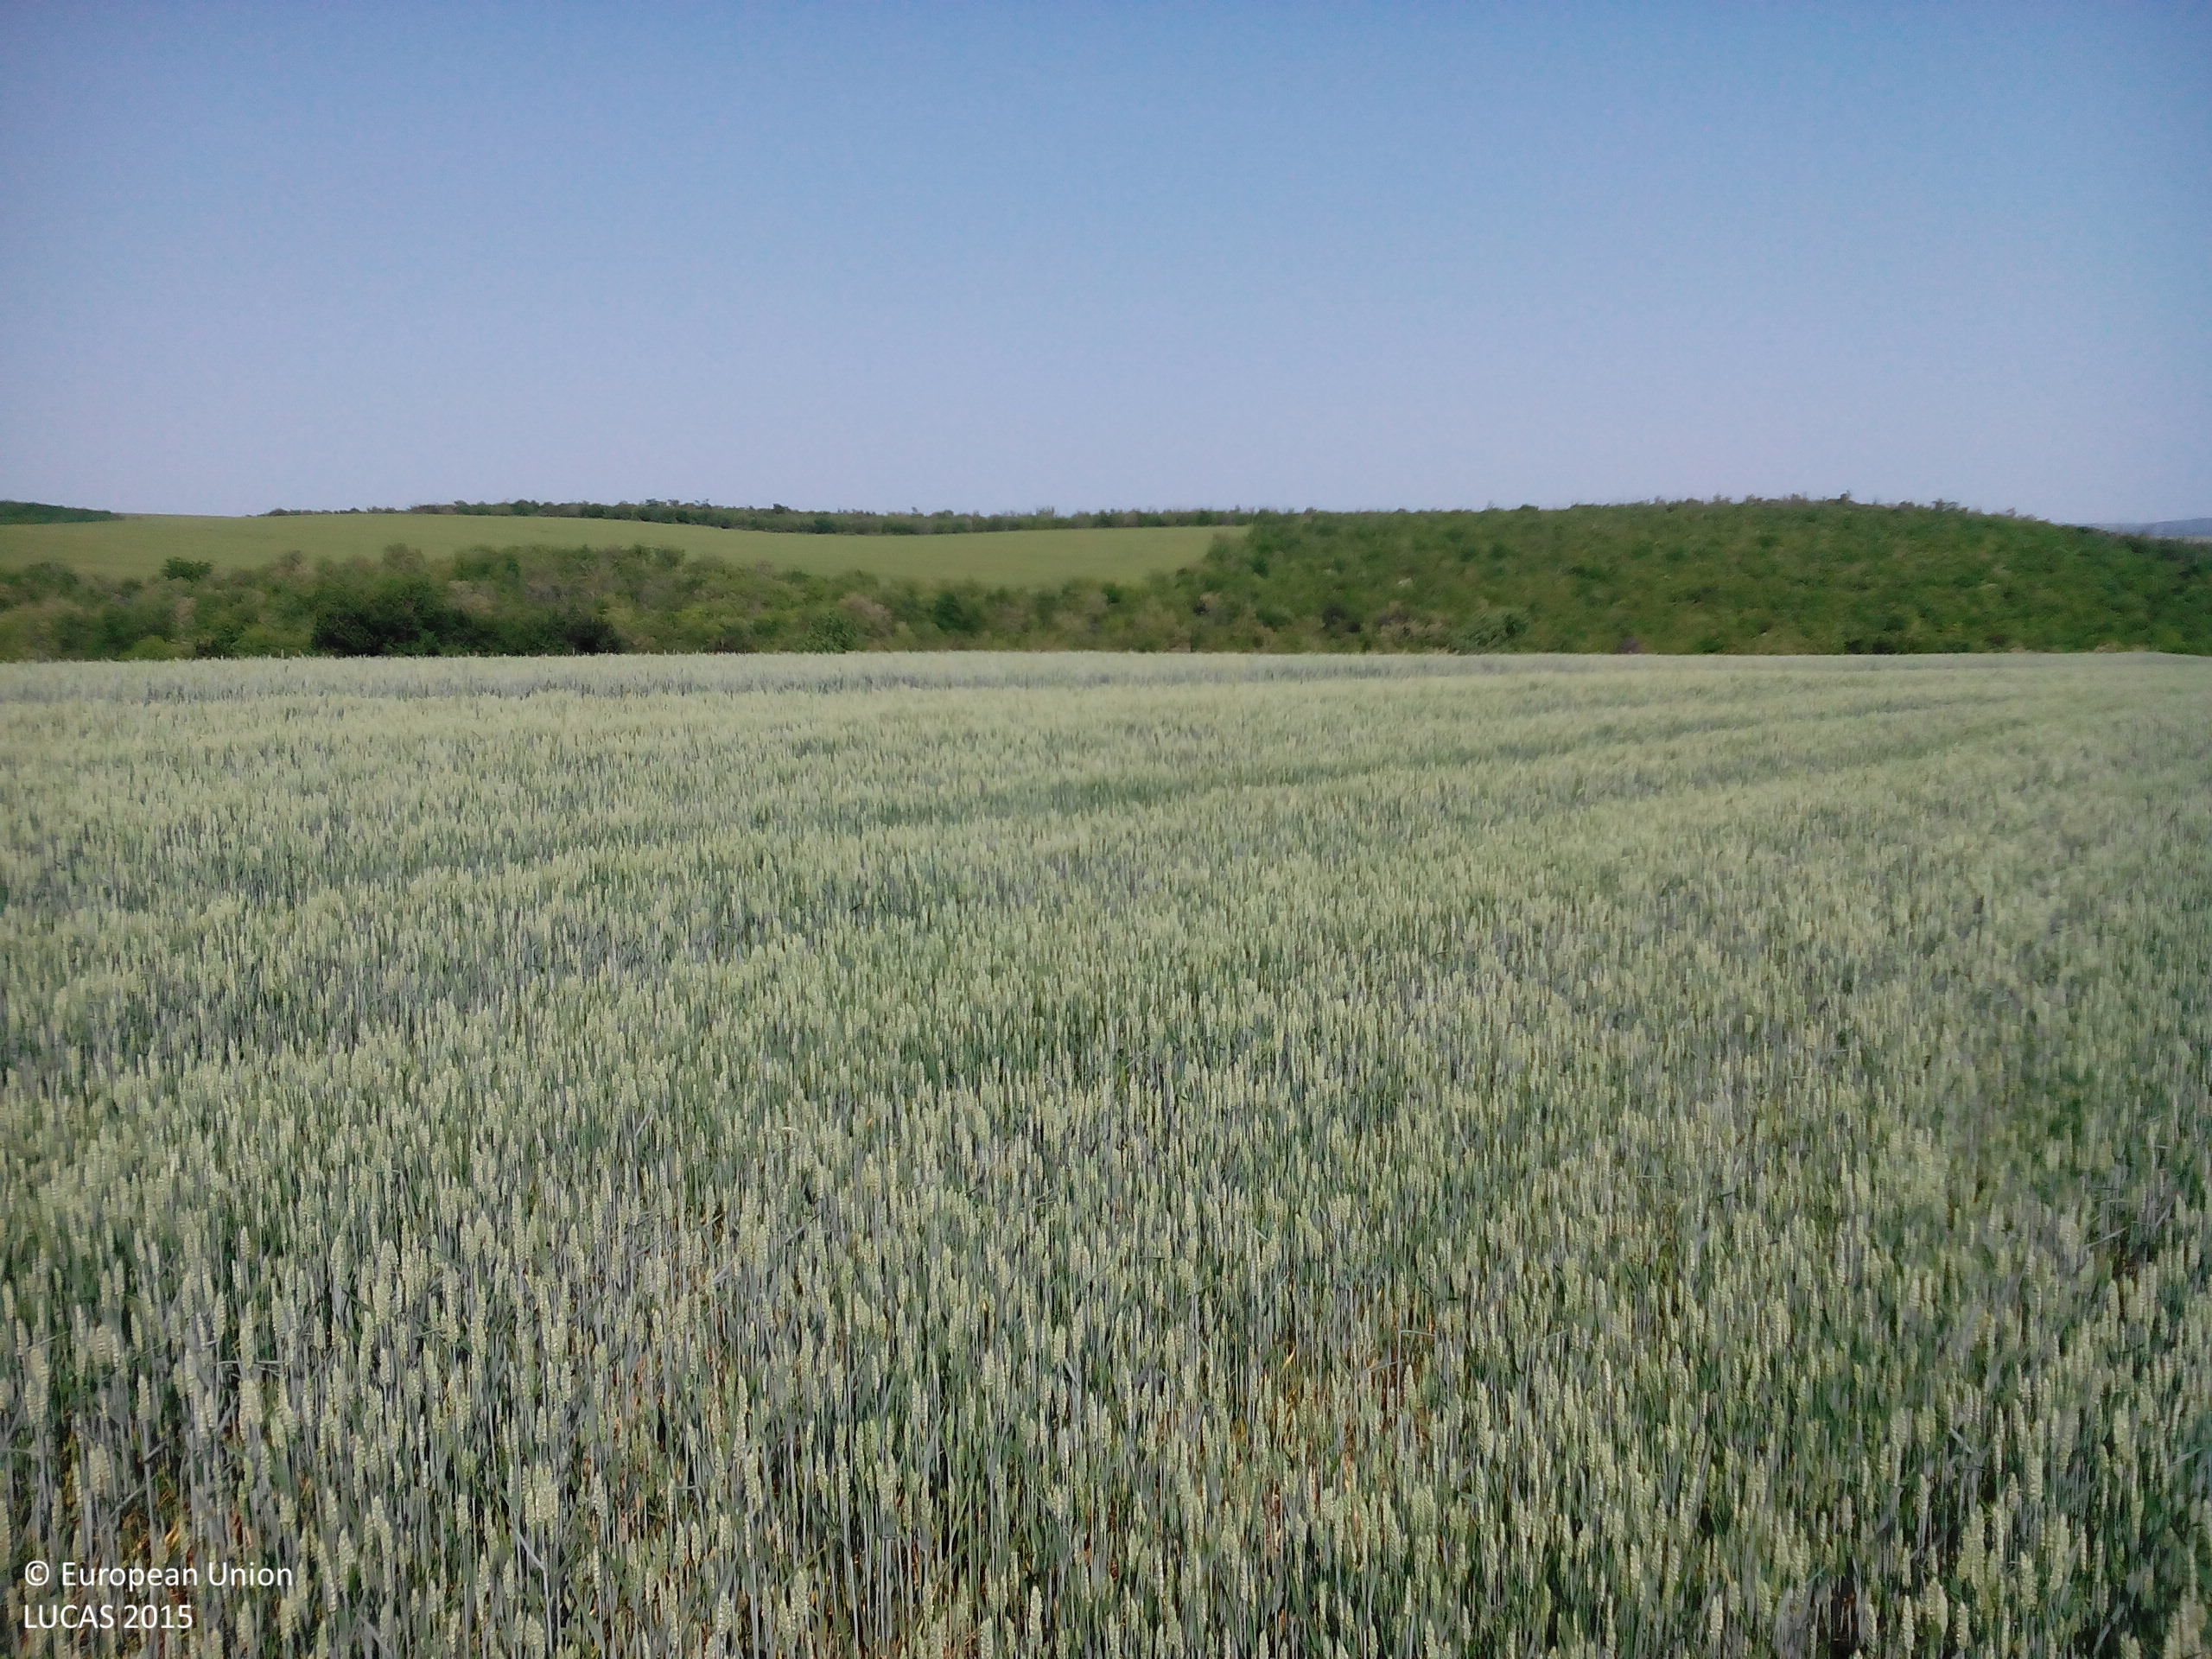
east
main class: Cropland
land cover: Common wheat
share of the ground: > 75 %
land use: Agriculture (excluding fallow land and kitchen gardens)
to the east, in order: Common wheat; Grassland with sparse tree/shrub cover; Broadleaved woodland; Grassland with sparse tree/shrub cover; Tracks; Grassland with sparse tree/shrub cover
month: May
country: BG
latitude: 43.6640
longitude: 24.3086
